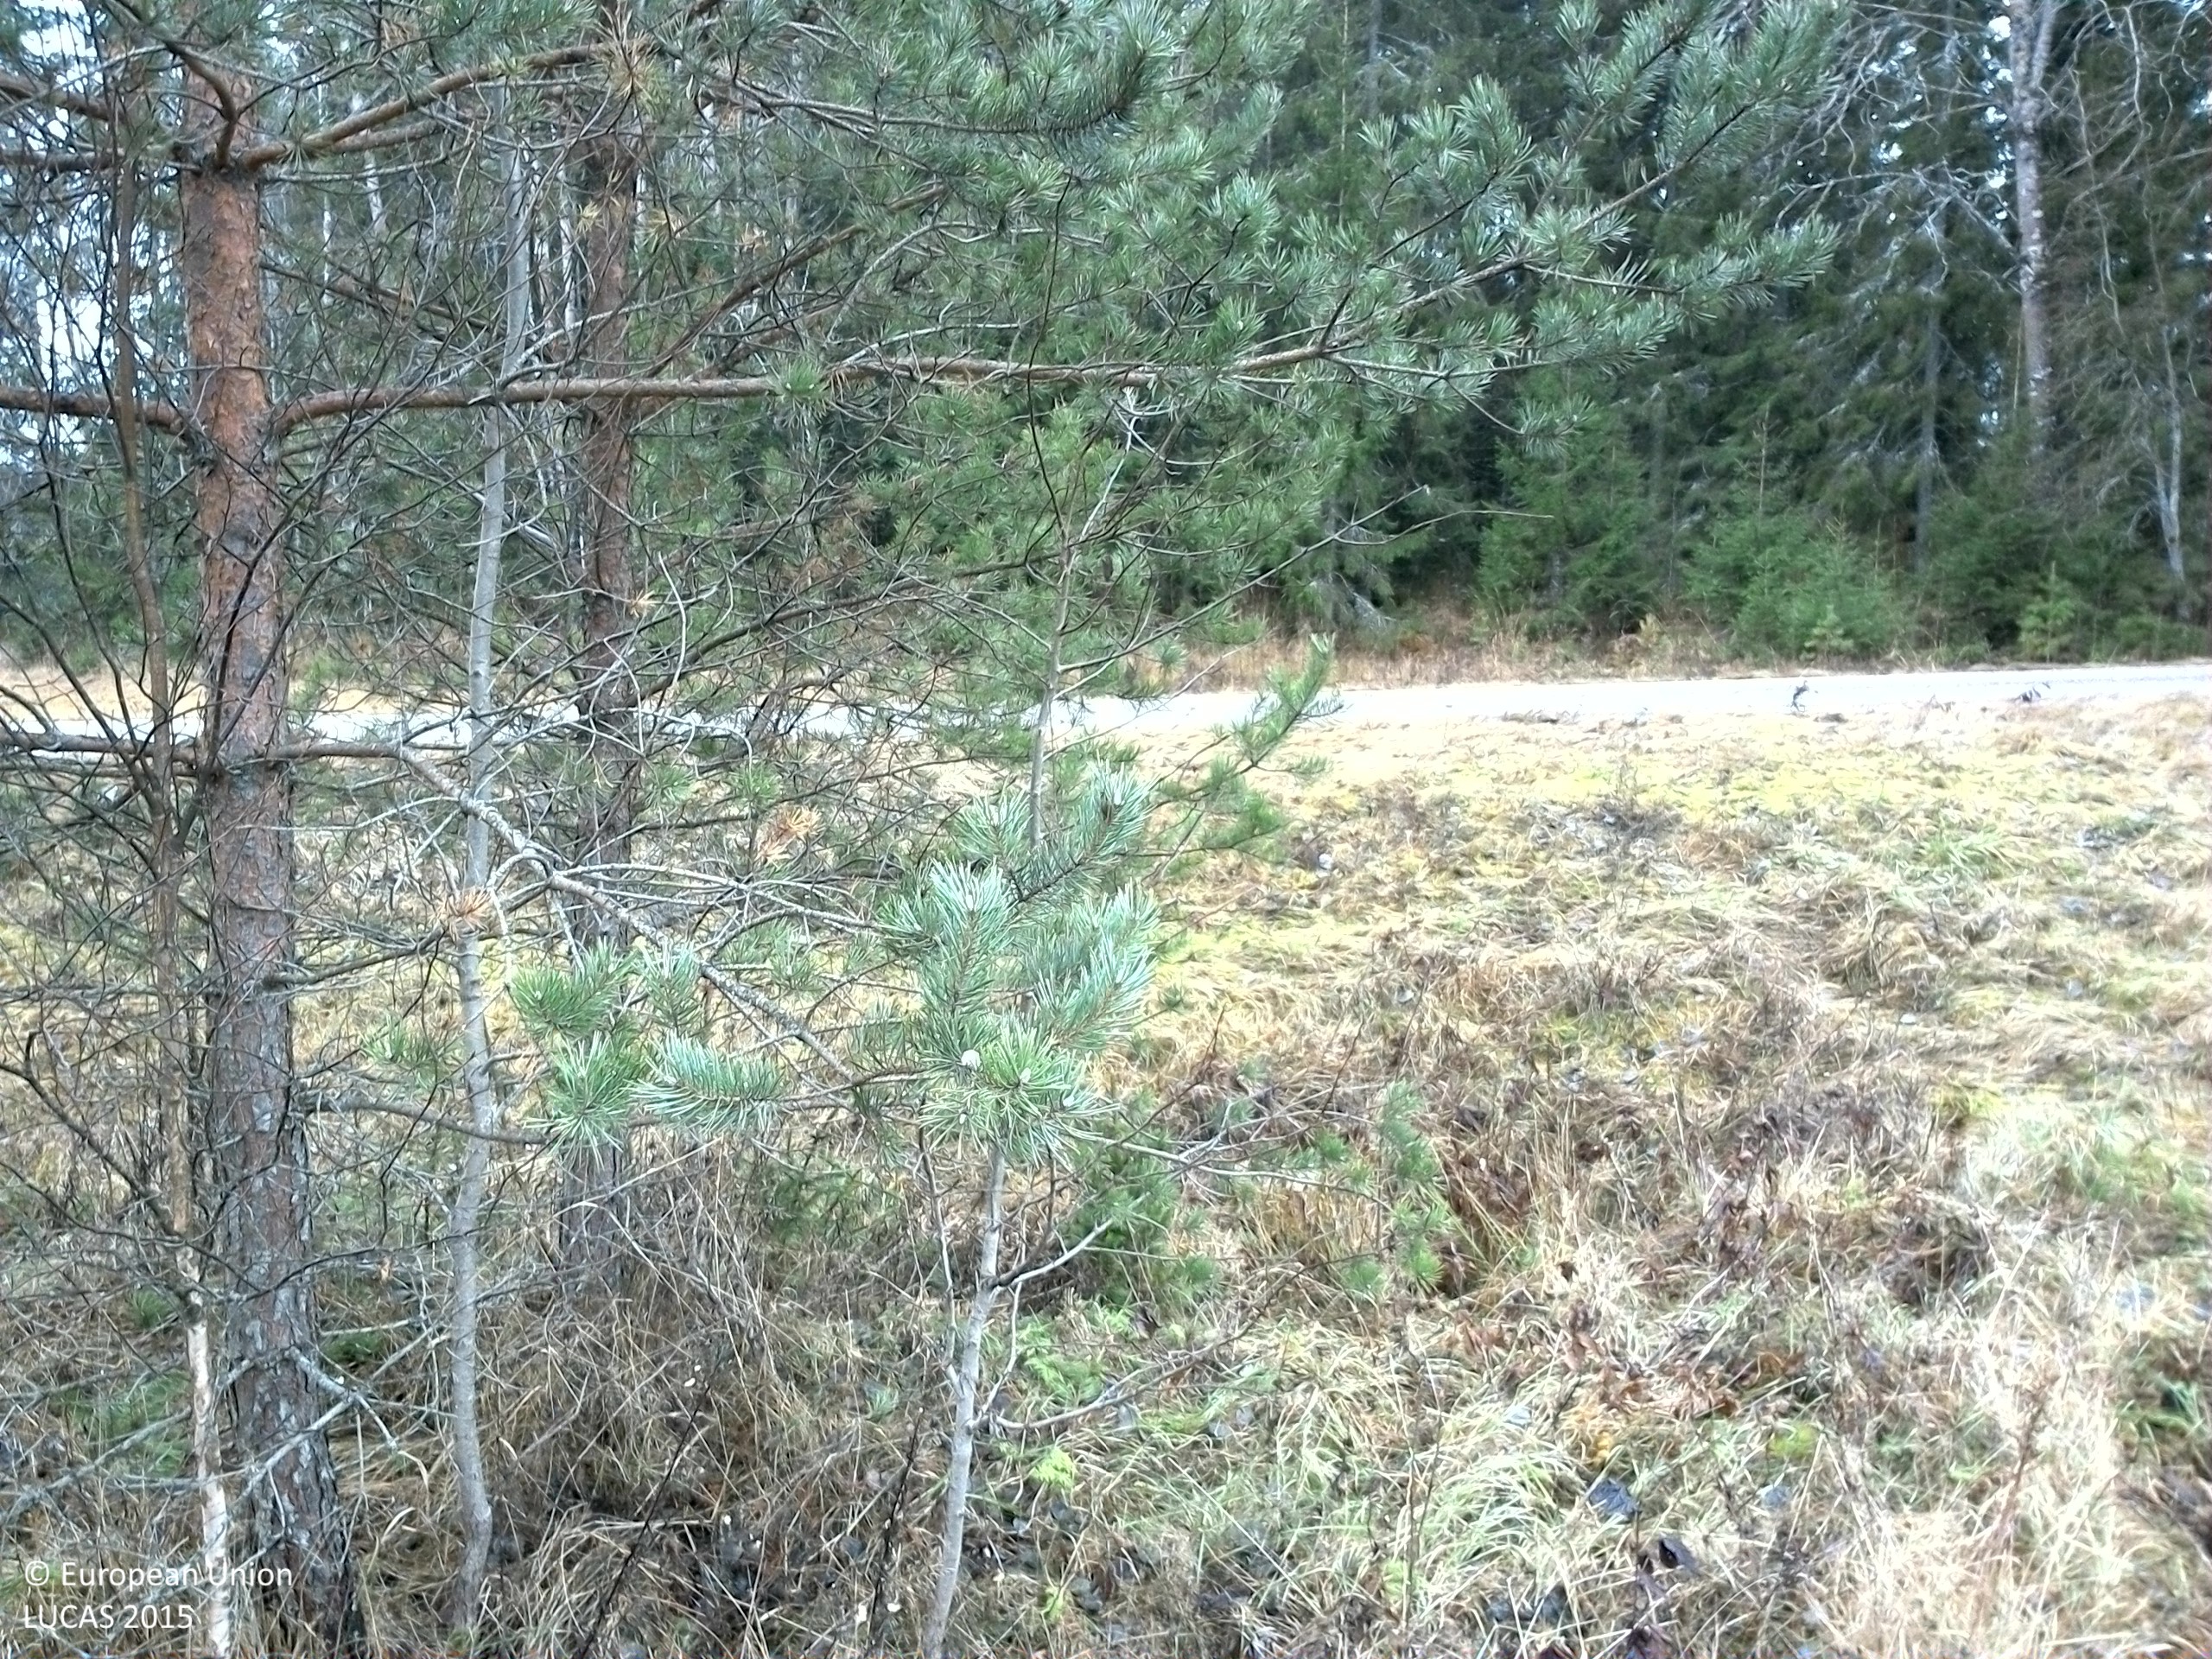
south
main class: Woodland
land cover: Pine dominated mixed woodland
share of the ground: 50 - 75 %
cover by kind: herbaceous plants 45 %, broadleaved forest trees 35 %, coniferous forest trees 20 %
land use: Semi-natural and natural areas not in use
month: November
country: SE
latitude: 59.2176
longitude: 16.8792
